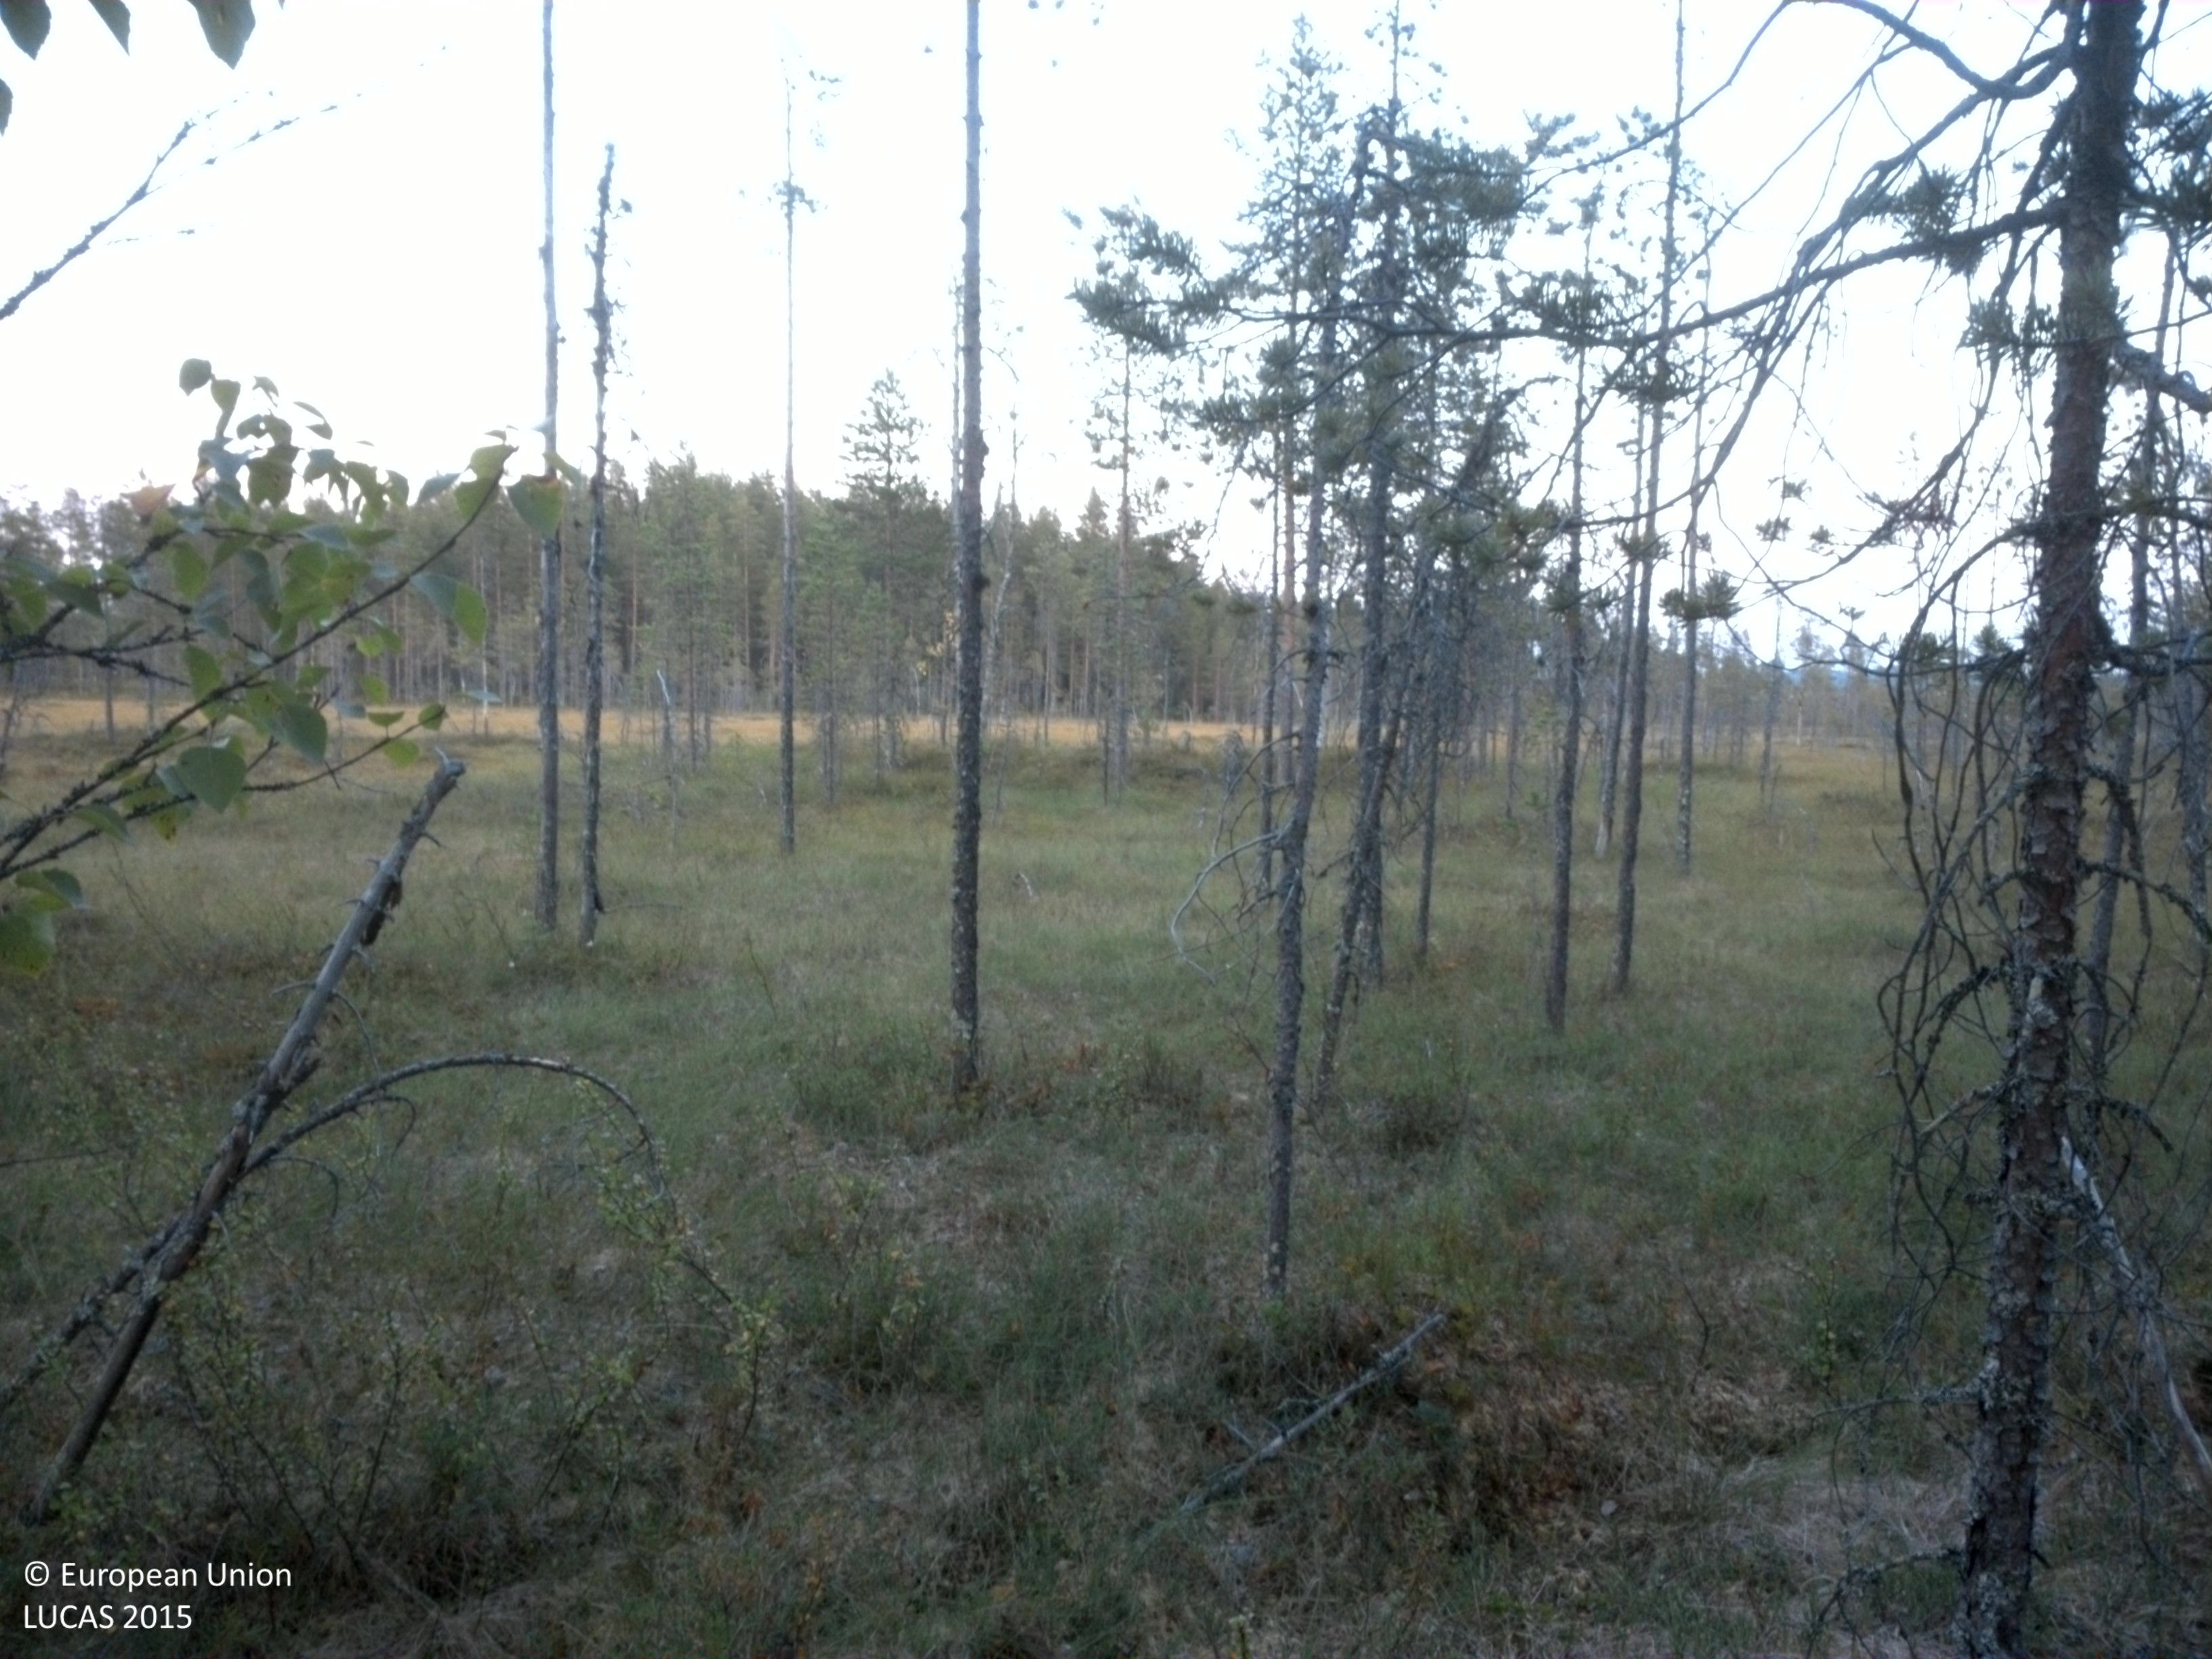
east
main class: Woodland
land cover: Pine dominated mixed woodland
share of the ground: 25 - 50 %
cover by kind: lichens and mosses 40 %, coniferous forest trees 30 %, broadleaved forest trees 10 %, shrubs 10 %, herbaceous plants 10 %
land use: Forestry
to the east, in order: Pine dominated mixed woodland; Peatbogs; Pine dominated coniferous woodland; Pine dominated mixed woodland
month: August
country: SE
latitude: 64.4938
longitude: 18.8985
